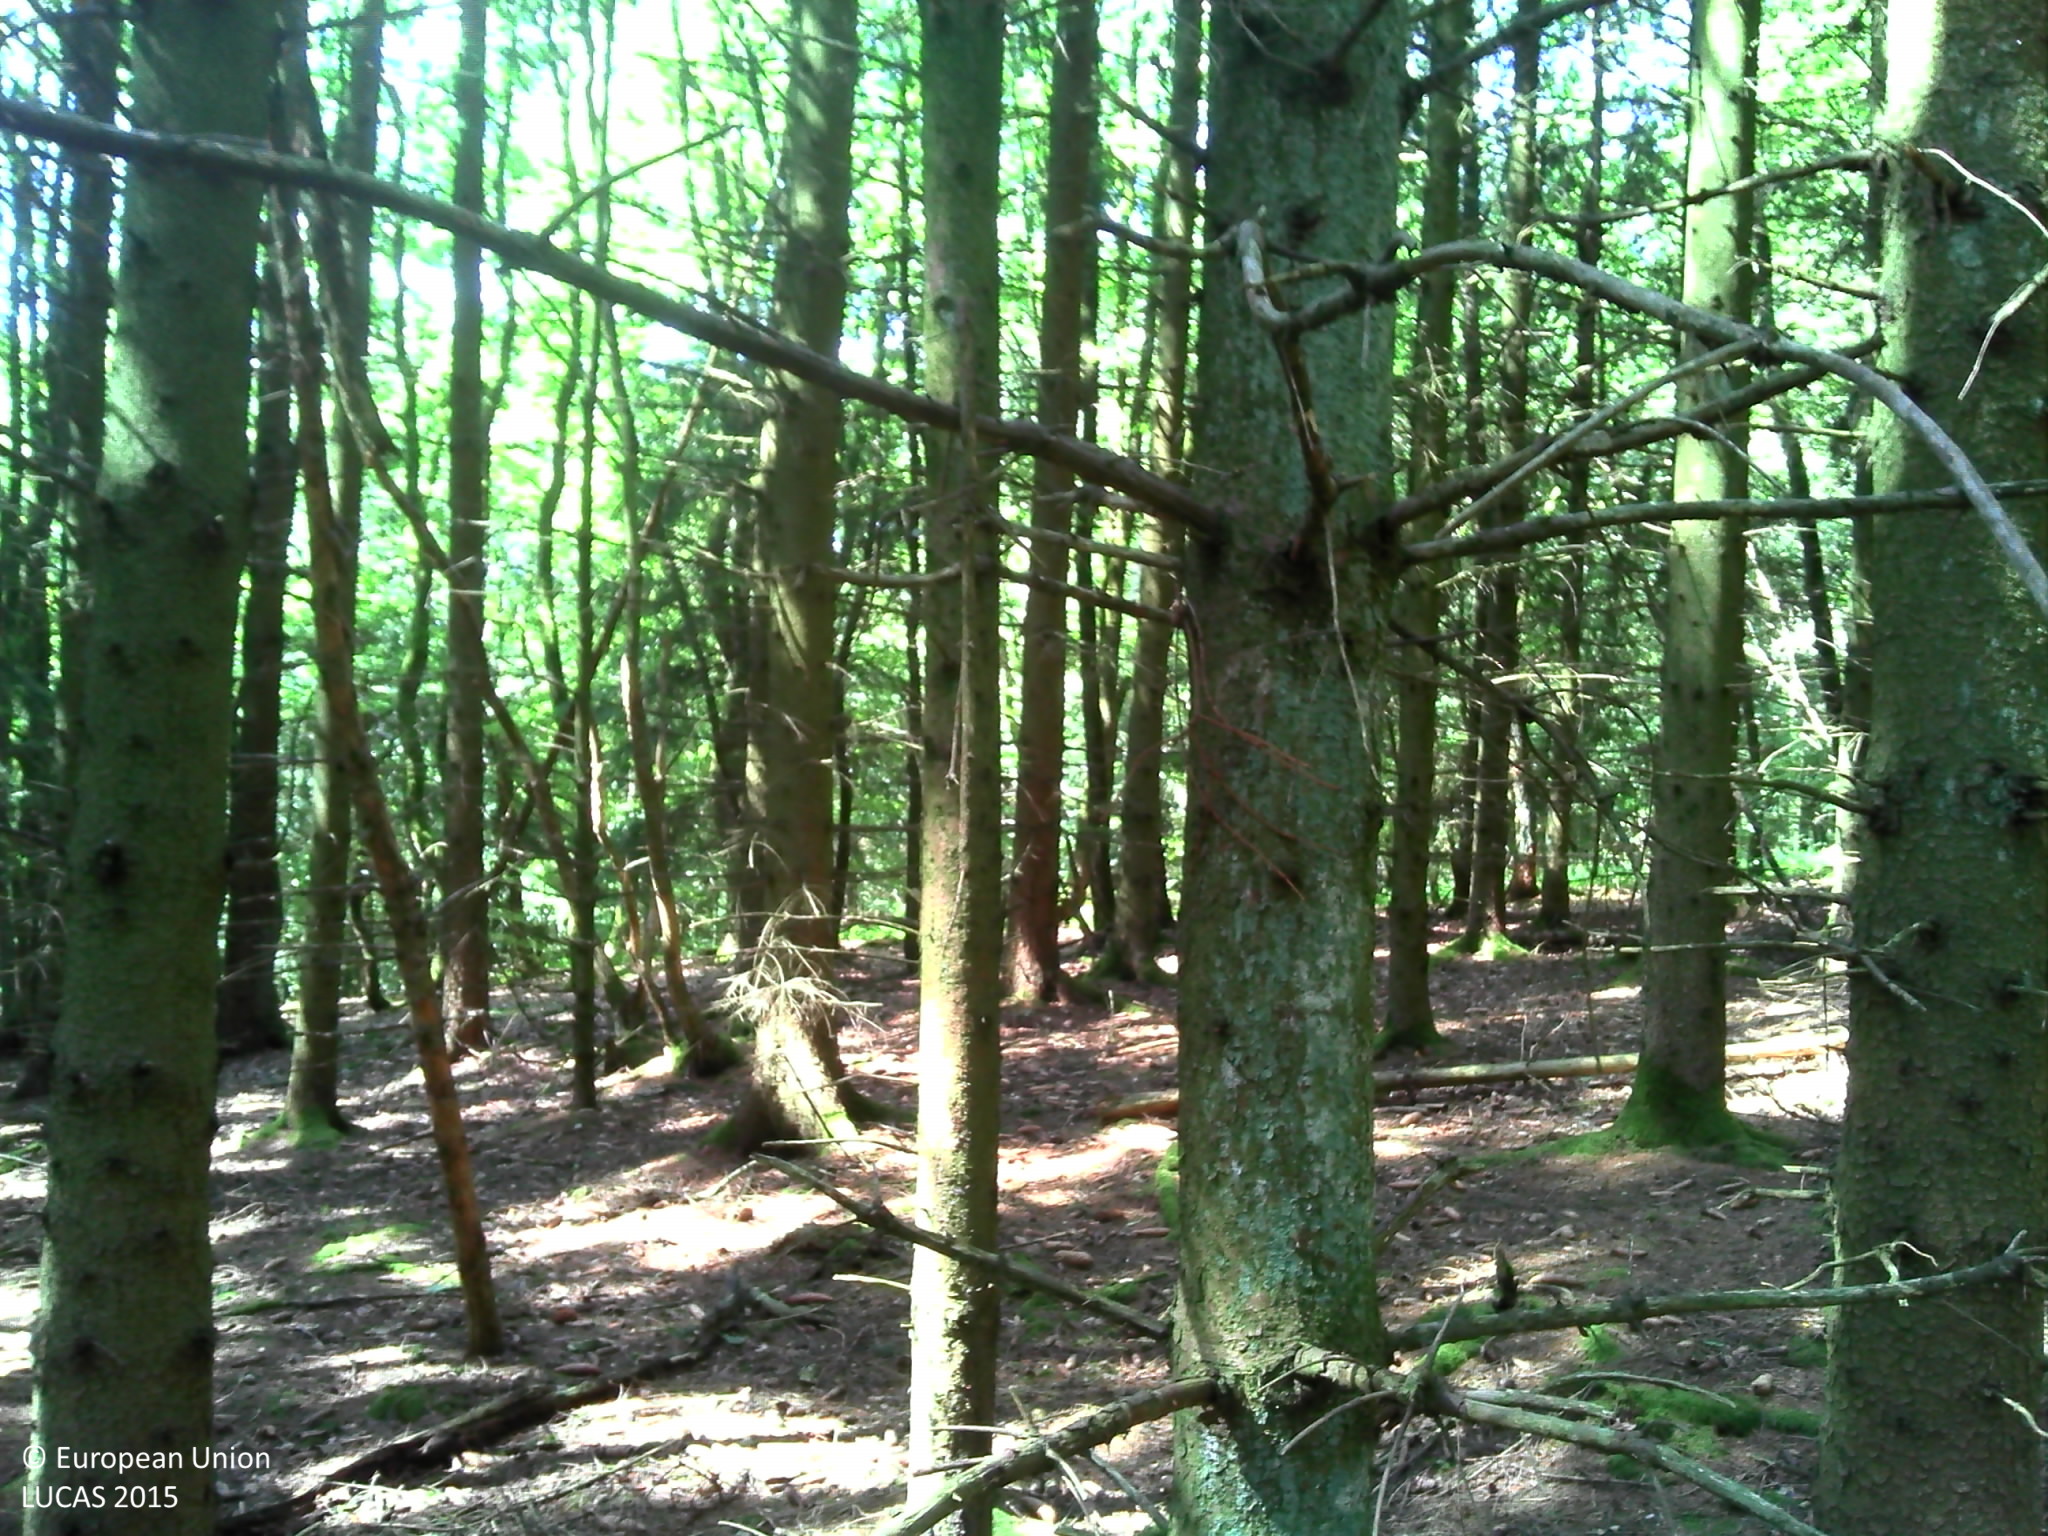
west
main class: Woodland
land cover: Spruce dominated coniferous woodland
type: exotic forest
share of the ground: > 75 %
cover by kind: coniferous forest trees 95 %, broadleaved forest trees 5 %
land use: Forestry
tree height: > 5 m
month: August
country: LU
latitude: 49.8214
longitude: 5.8708
